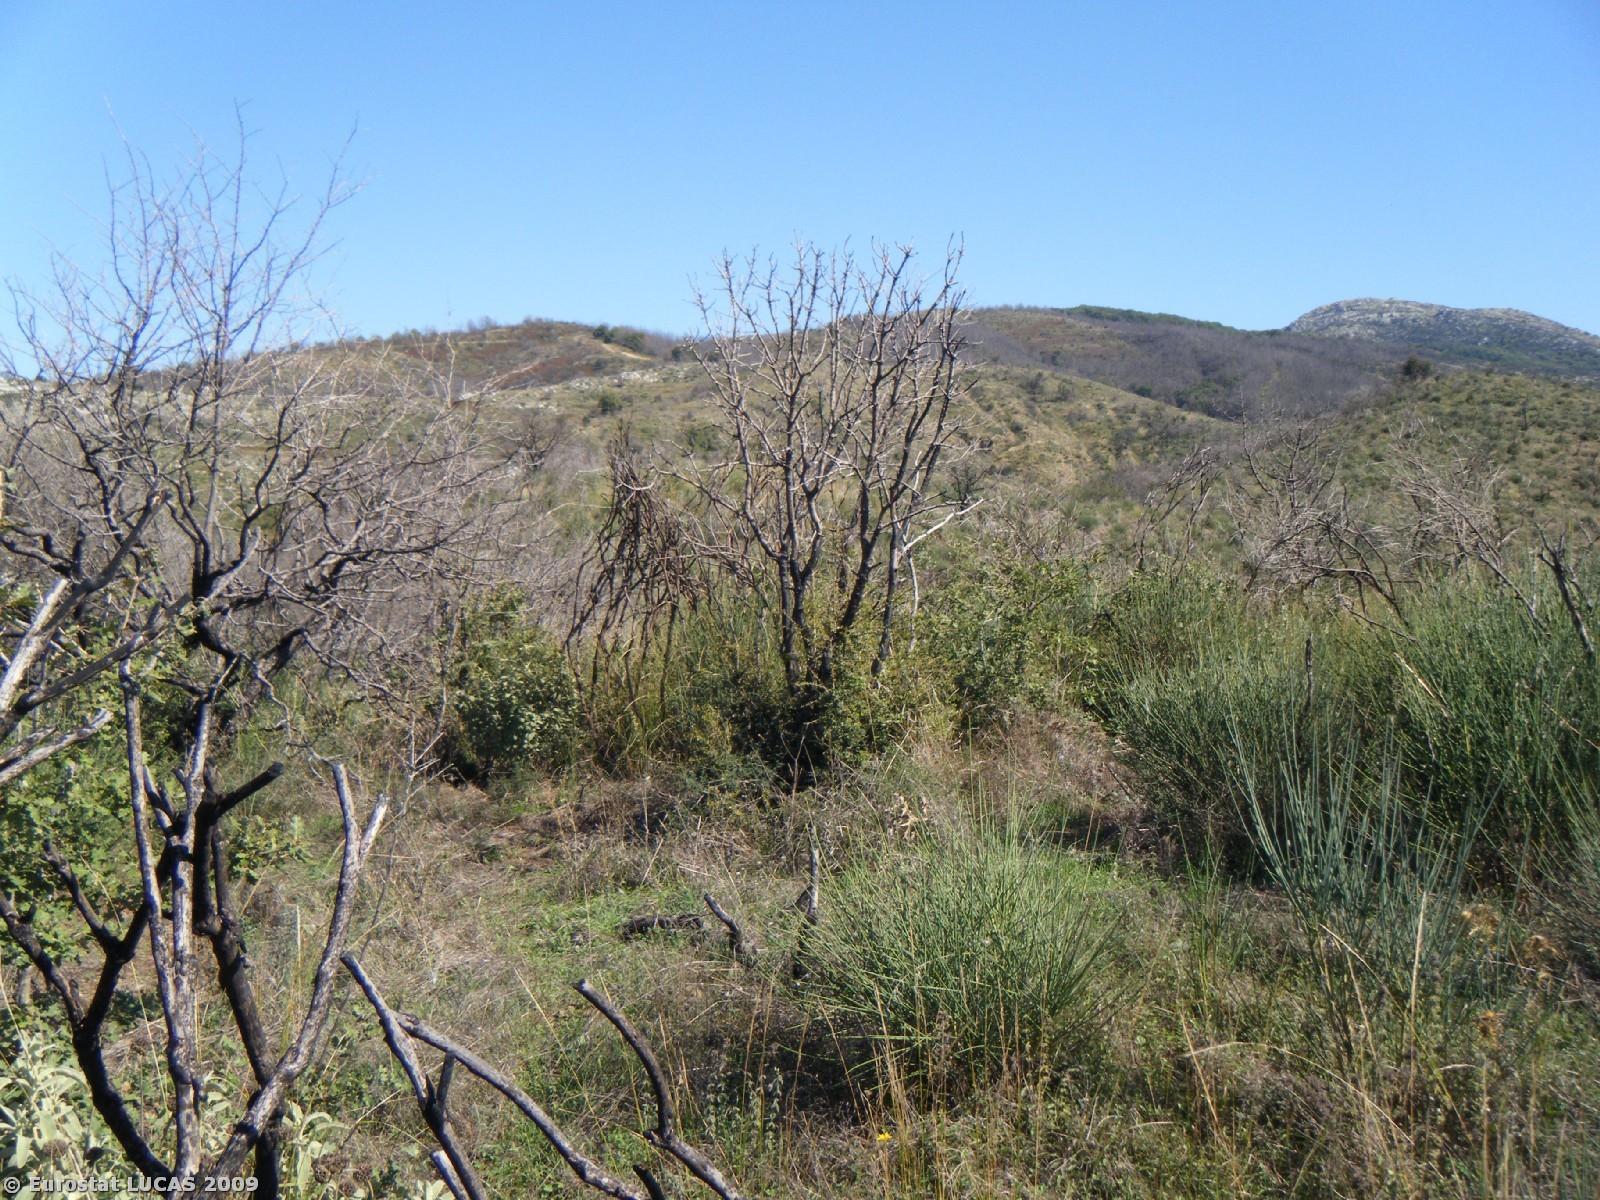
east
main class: Grassland
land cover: Grassland with sparse tree/shrub cover
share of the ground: > 75 %
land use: Unused
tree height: > 5 m
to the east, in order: Grassland with sparse tree/shrub cover; Shrubland without tree cover; Other structural elements; Shrubland without tree cover
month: October
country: GR
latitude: 37.4324
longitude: 22.2217
